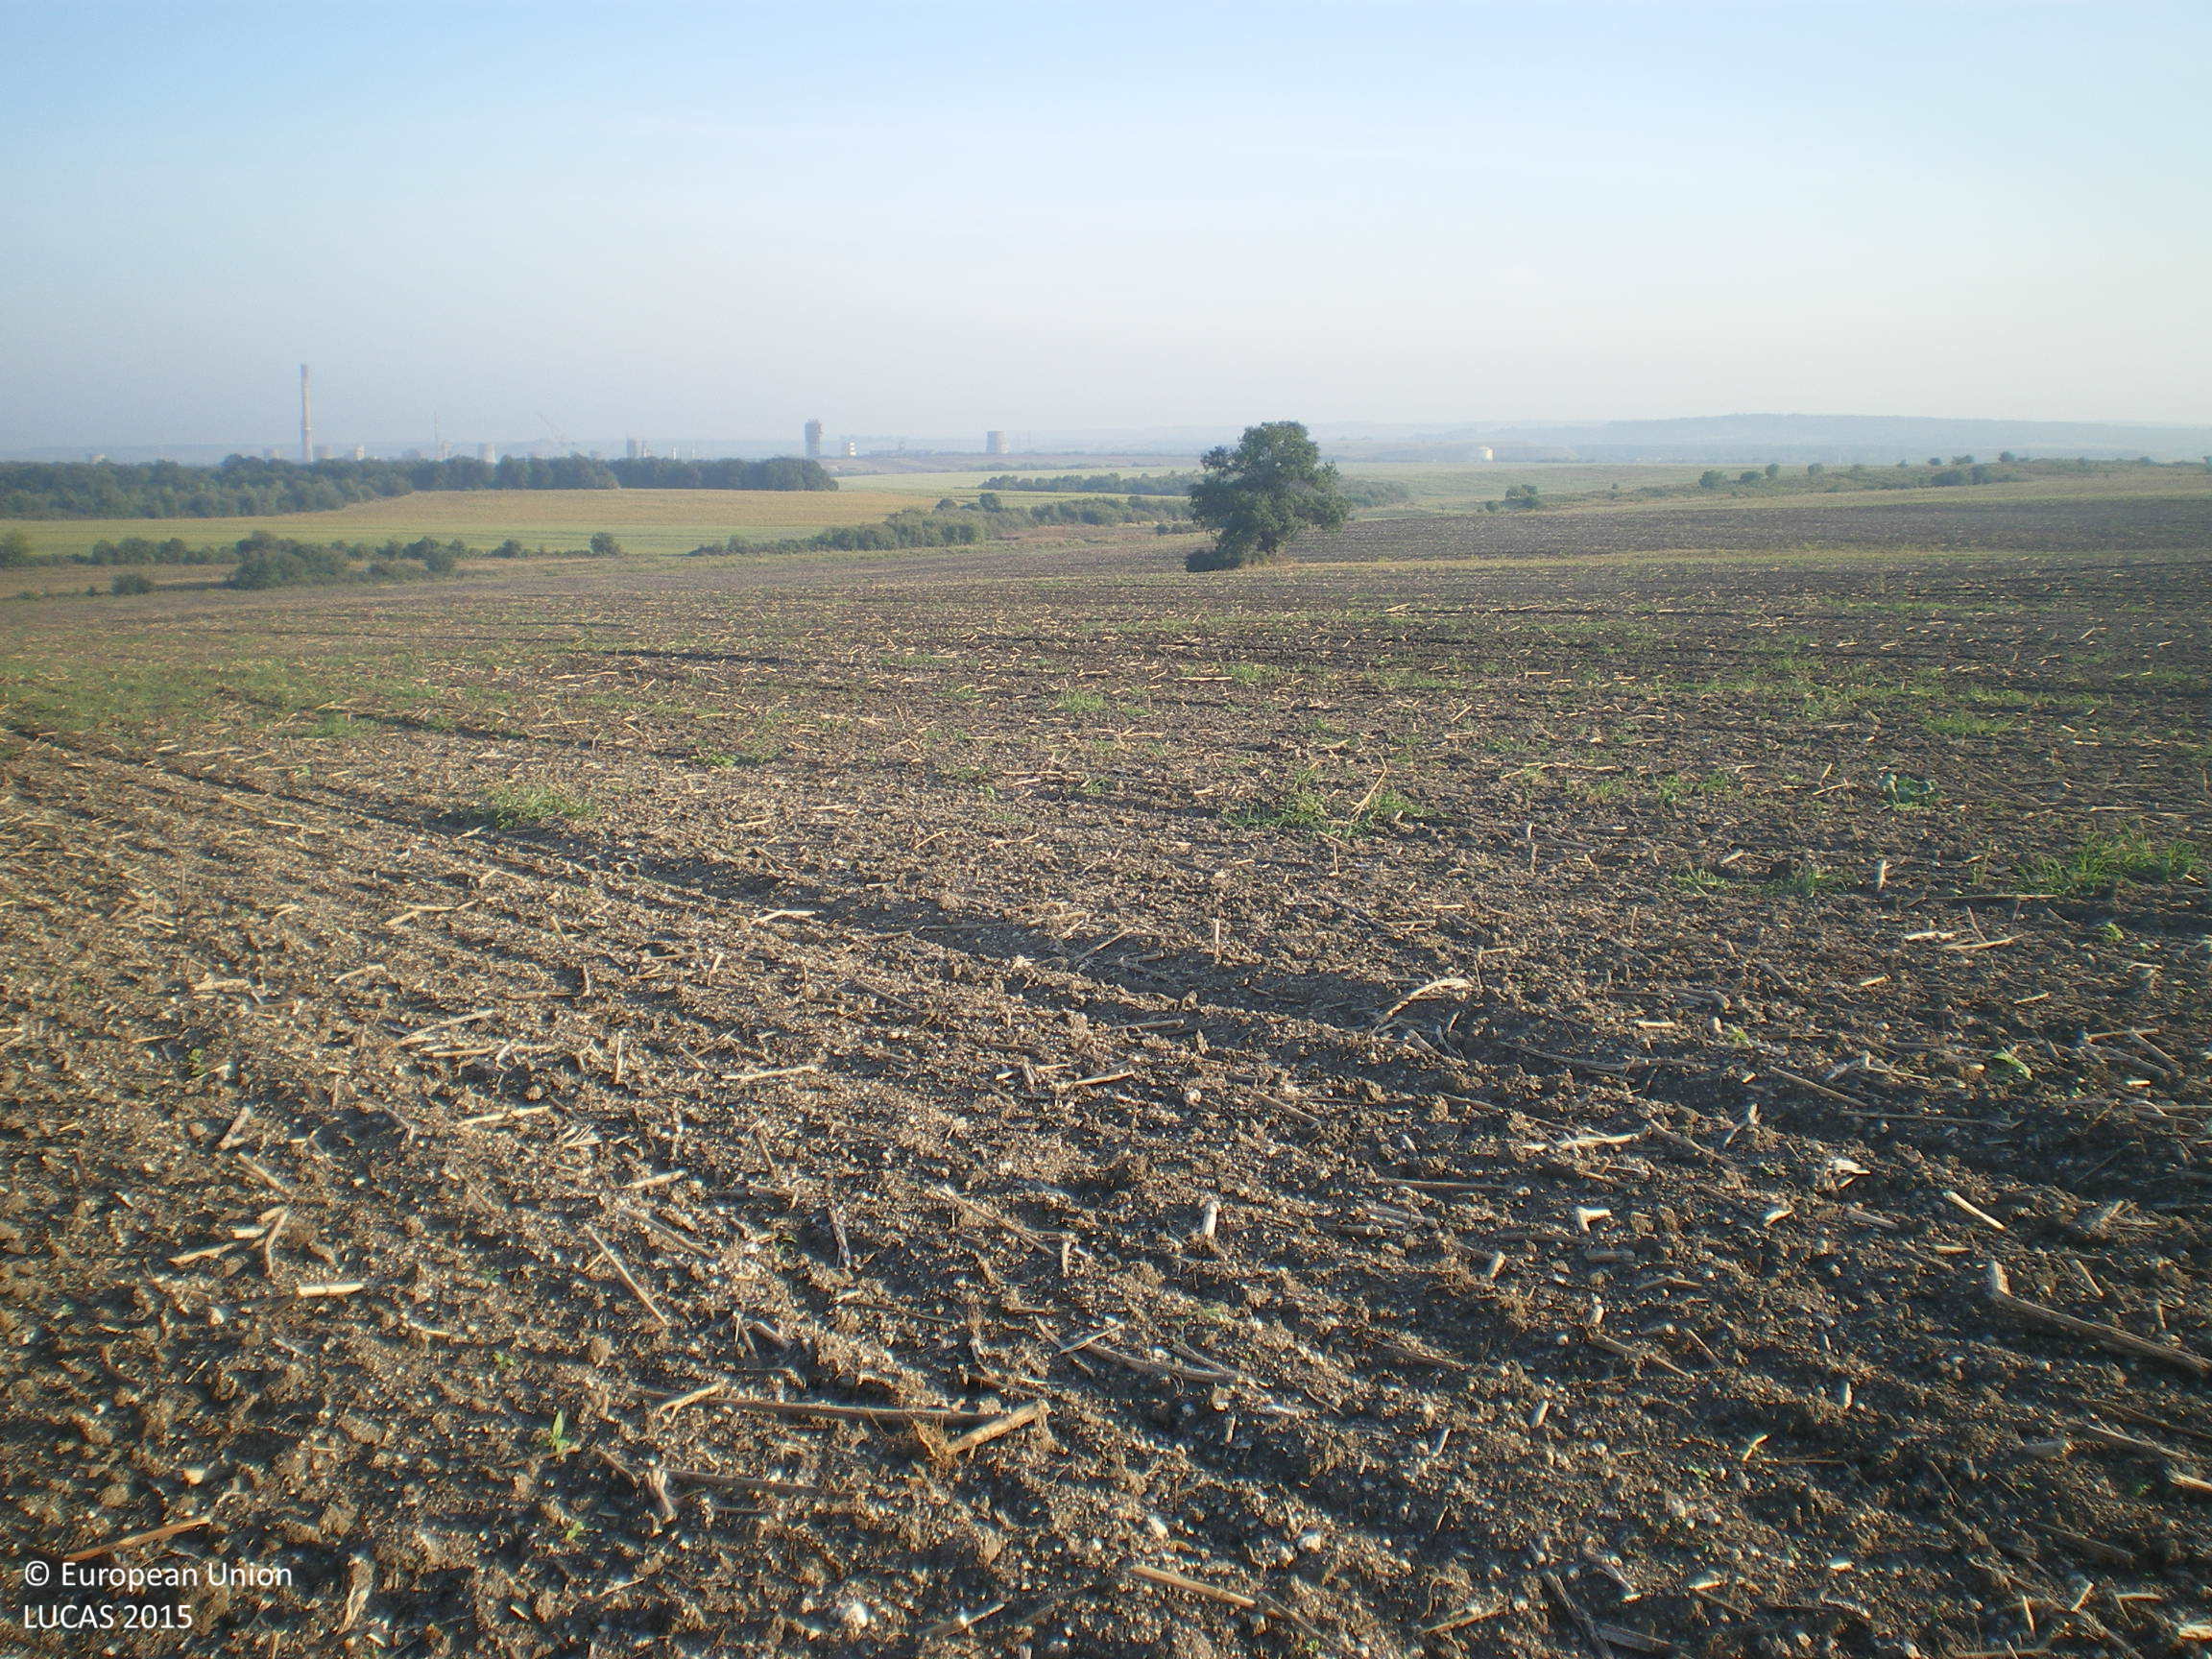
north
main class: Cropland
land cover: Sunflower
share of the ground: < 10 %
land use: Agriculture (excluding fallow land and kitchen gardens)
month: September
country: BG
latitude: 42.0189
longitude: 25.6334
